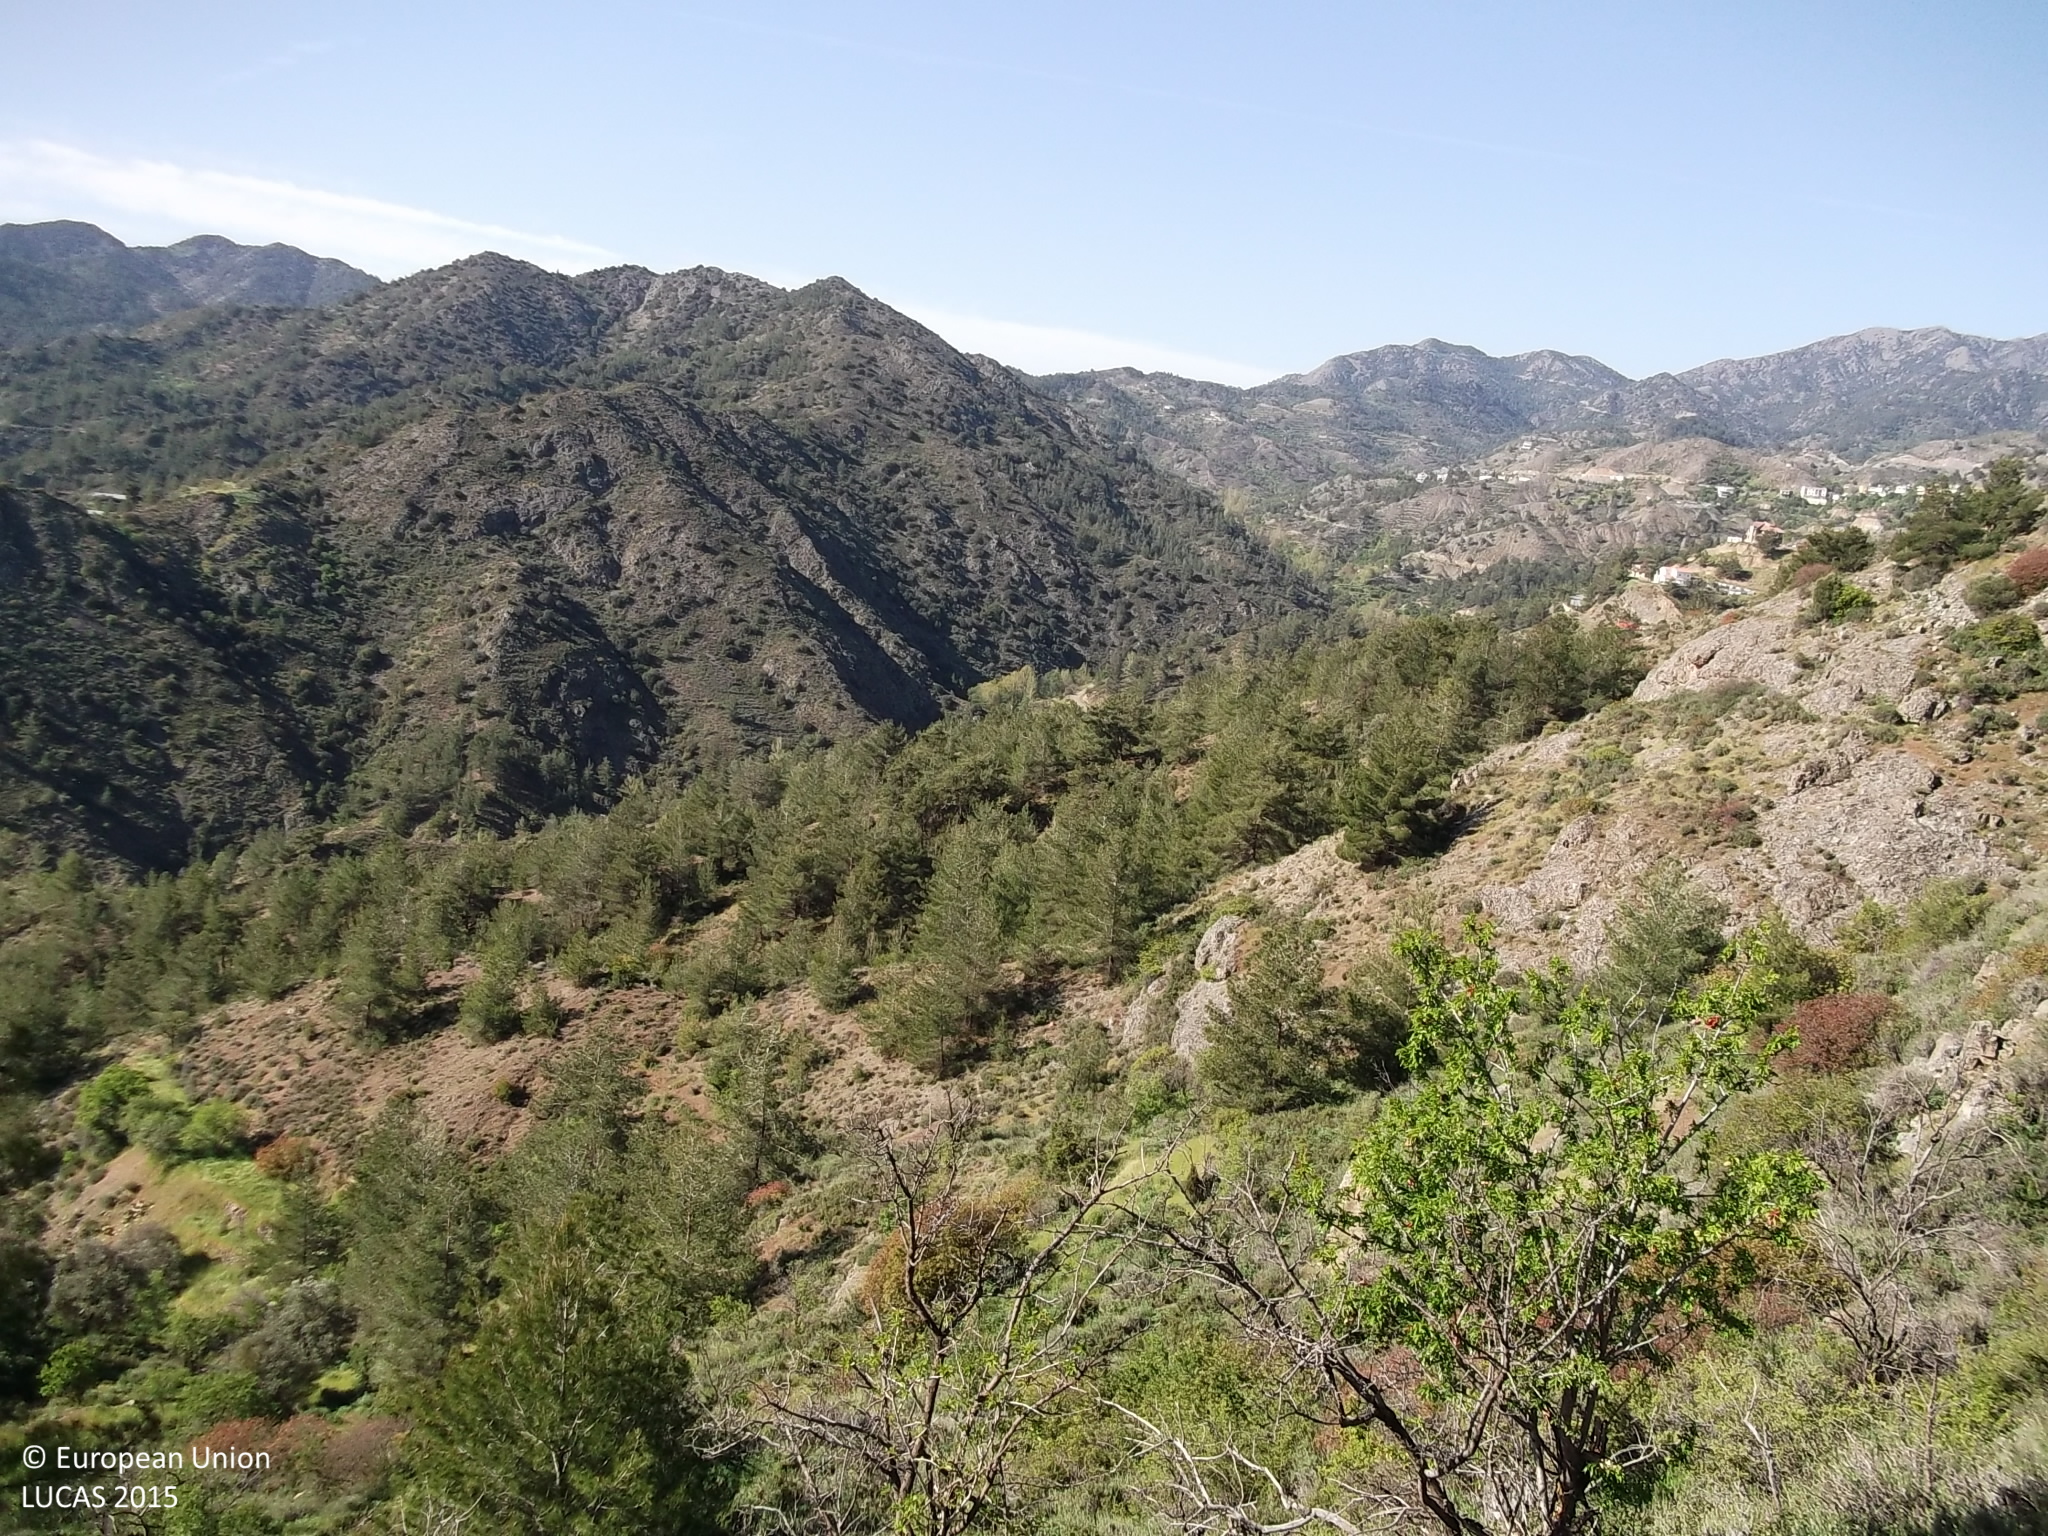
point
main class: Woodland
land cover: Pine dominated mixed woodland
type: coniferous forest of the mediterranean region
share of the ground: 10 - 25 %
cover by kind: shrubs 45 %, unconsolidated bare surface 30 %, coniferous forest trees 15 %, broadleaved forest trees 10 %
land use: Semi-natural and natural areas not in use
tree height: > 5 m
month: April
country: CY
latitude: 34.9341
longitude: 33.1121
